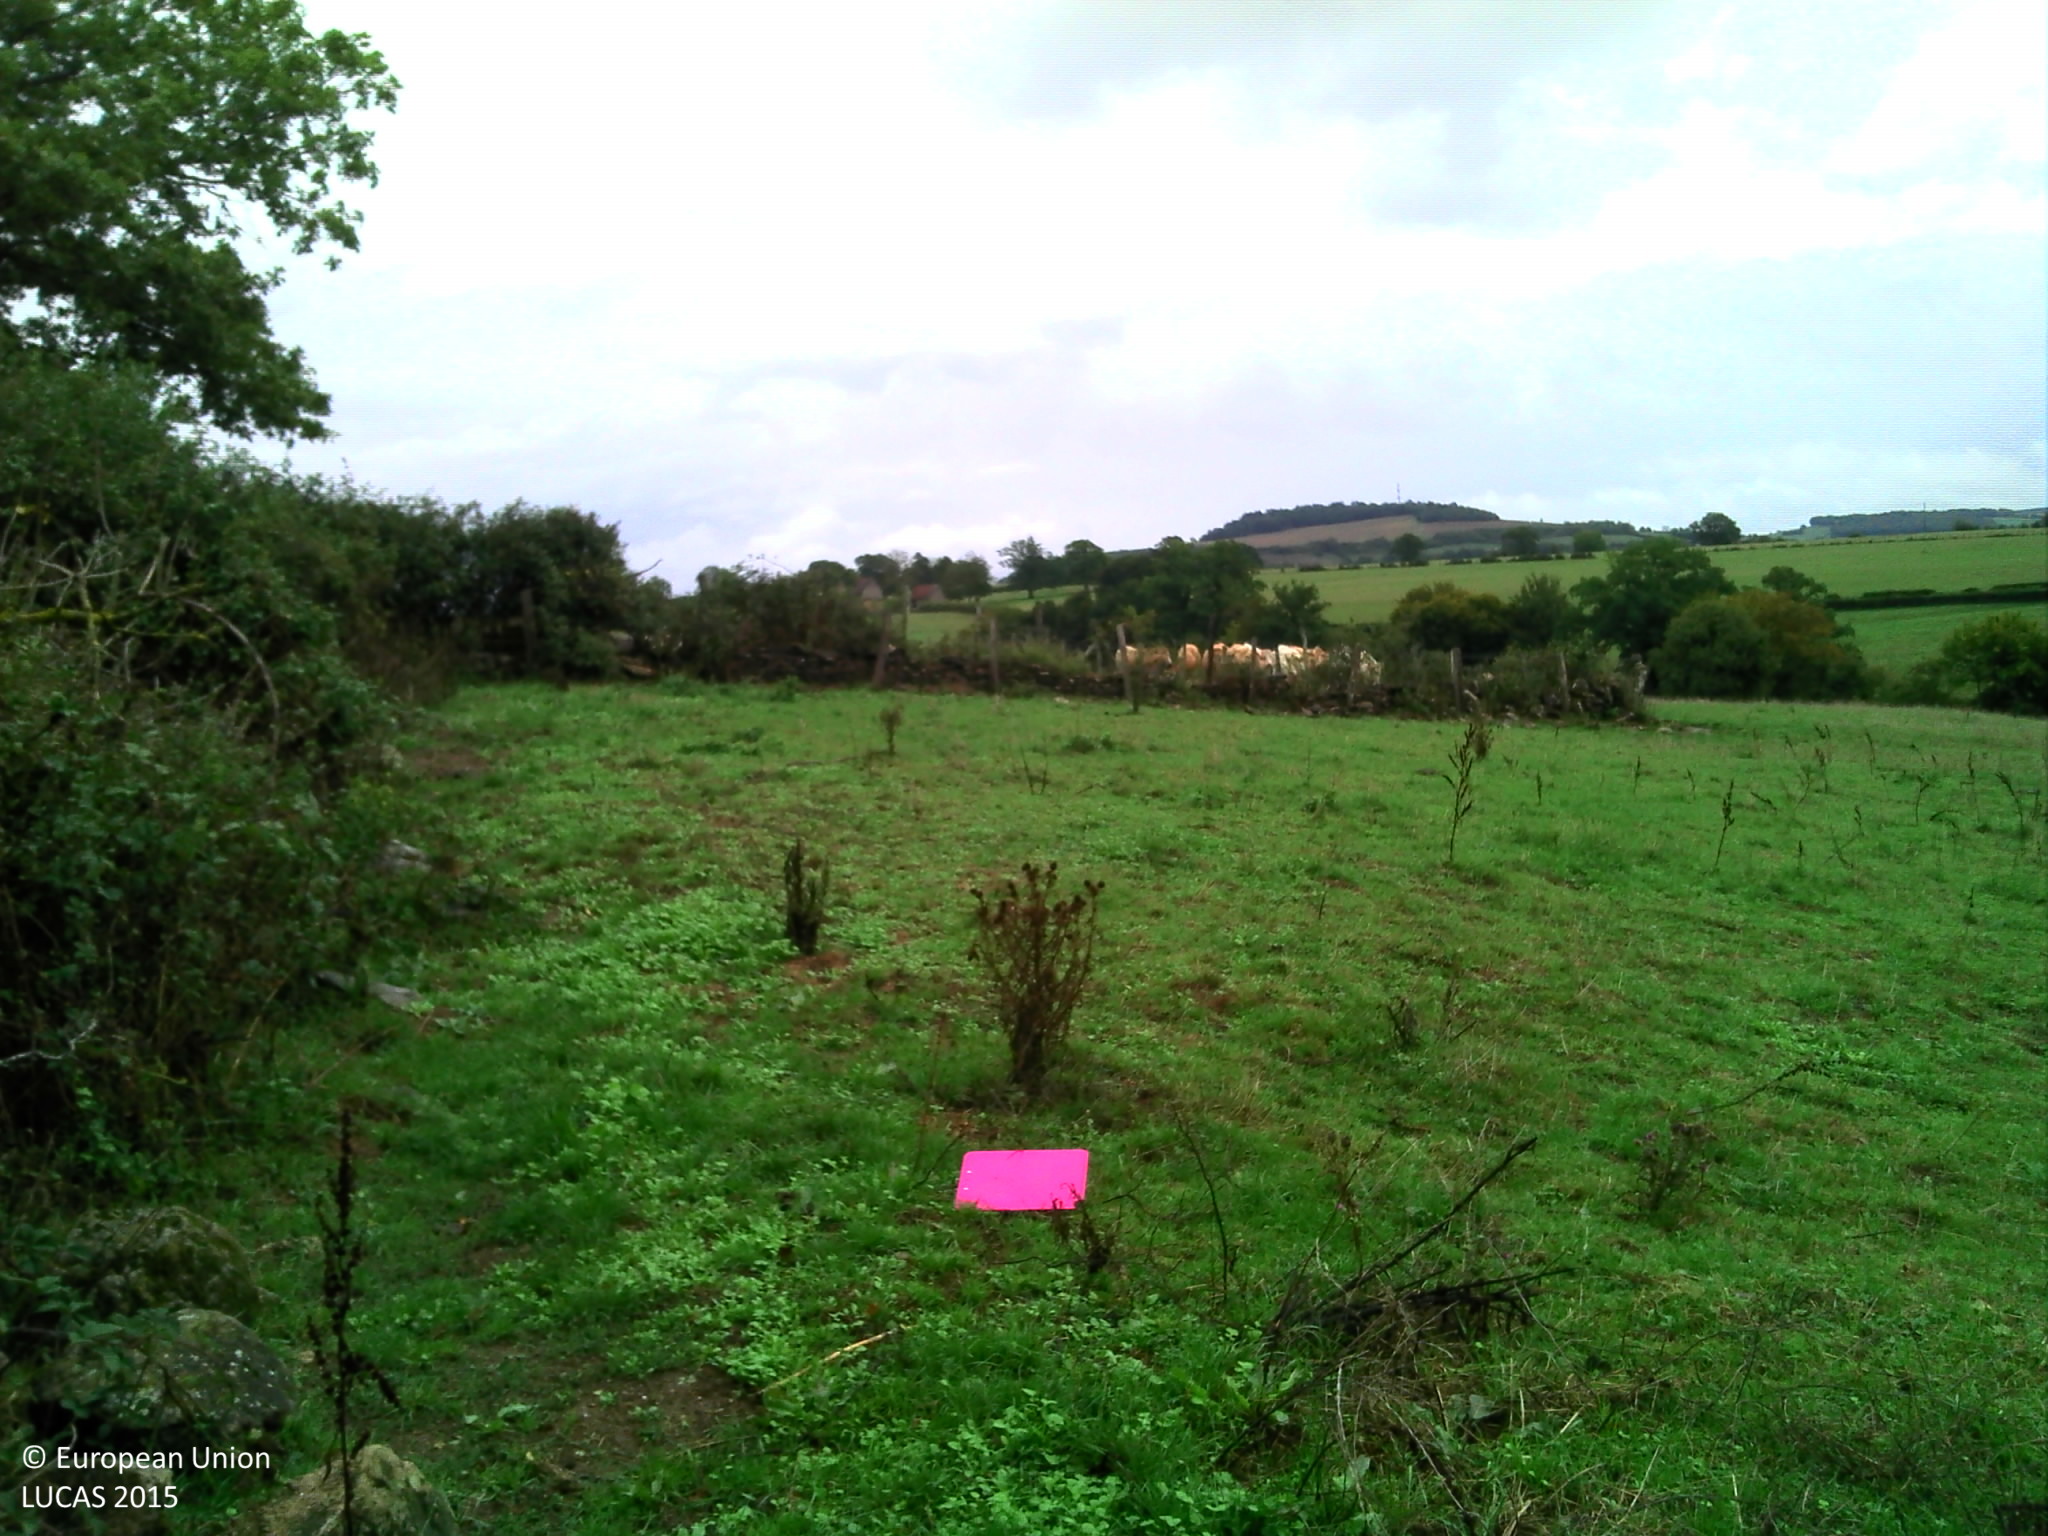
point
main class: Grassland
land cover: Grassland without tree/shrub cover
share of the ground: > 75 %
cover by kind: herbaceous plants 100 %
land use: Agriculture (excluding fallow land and kitchen gardens)
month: September
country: FR
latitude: 47.3554
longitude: 4.3194
